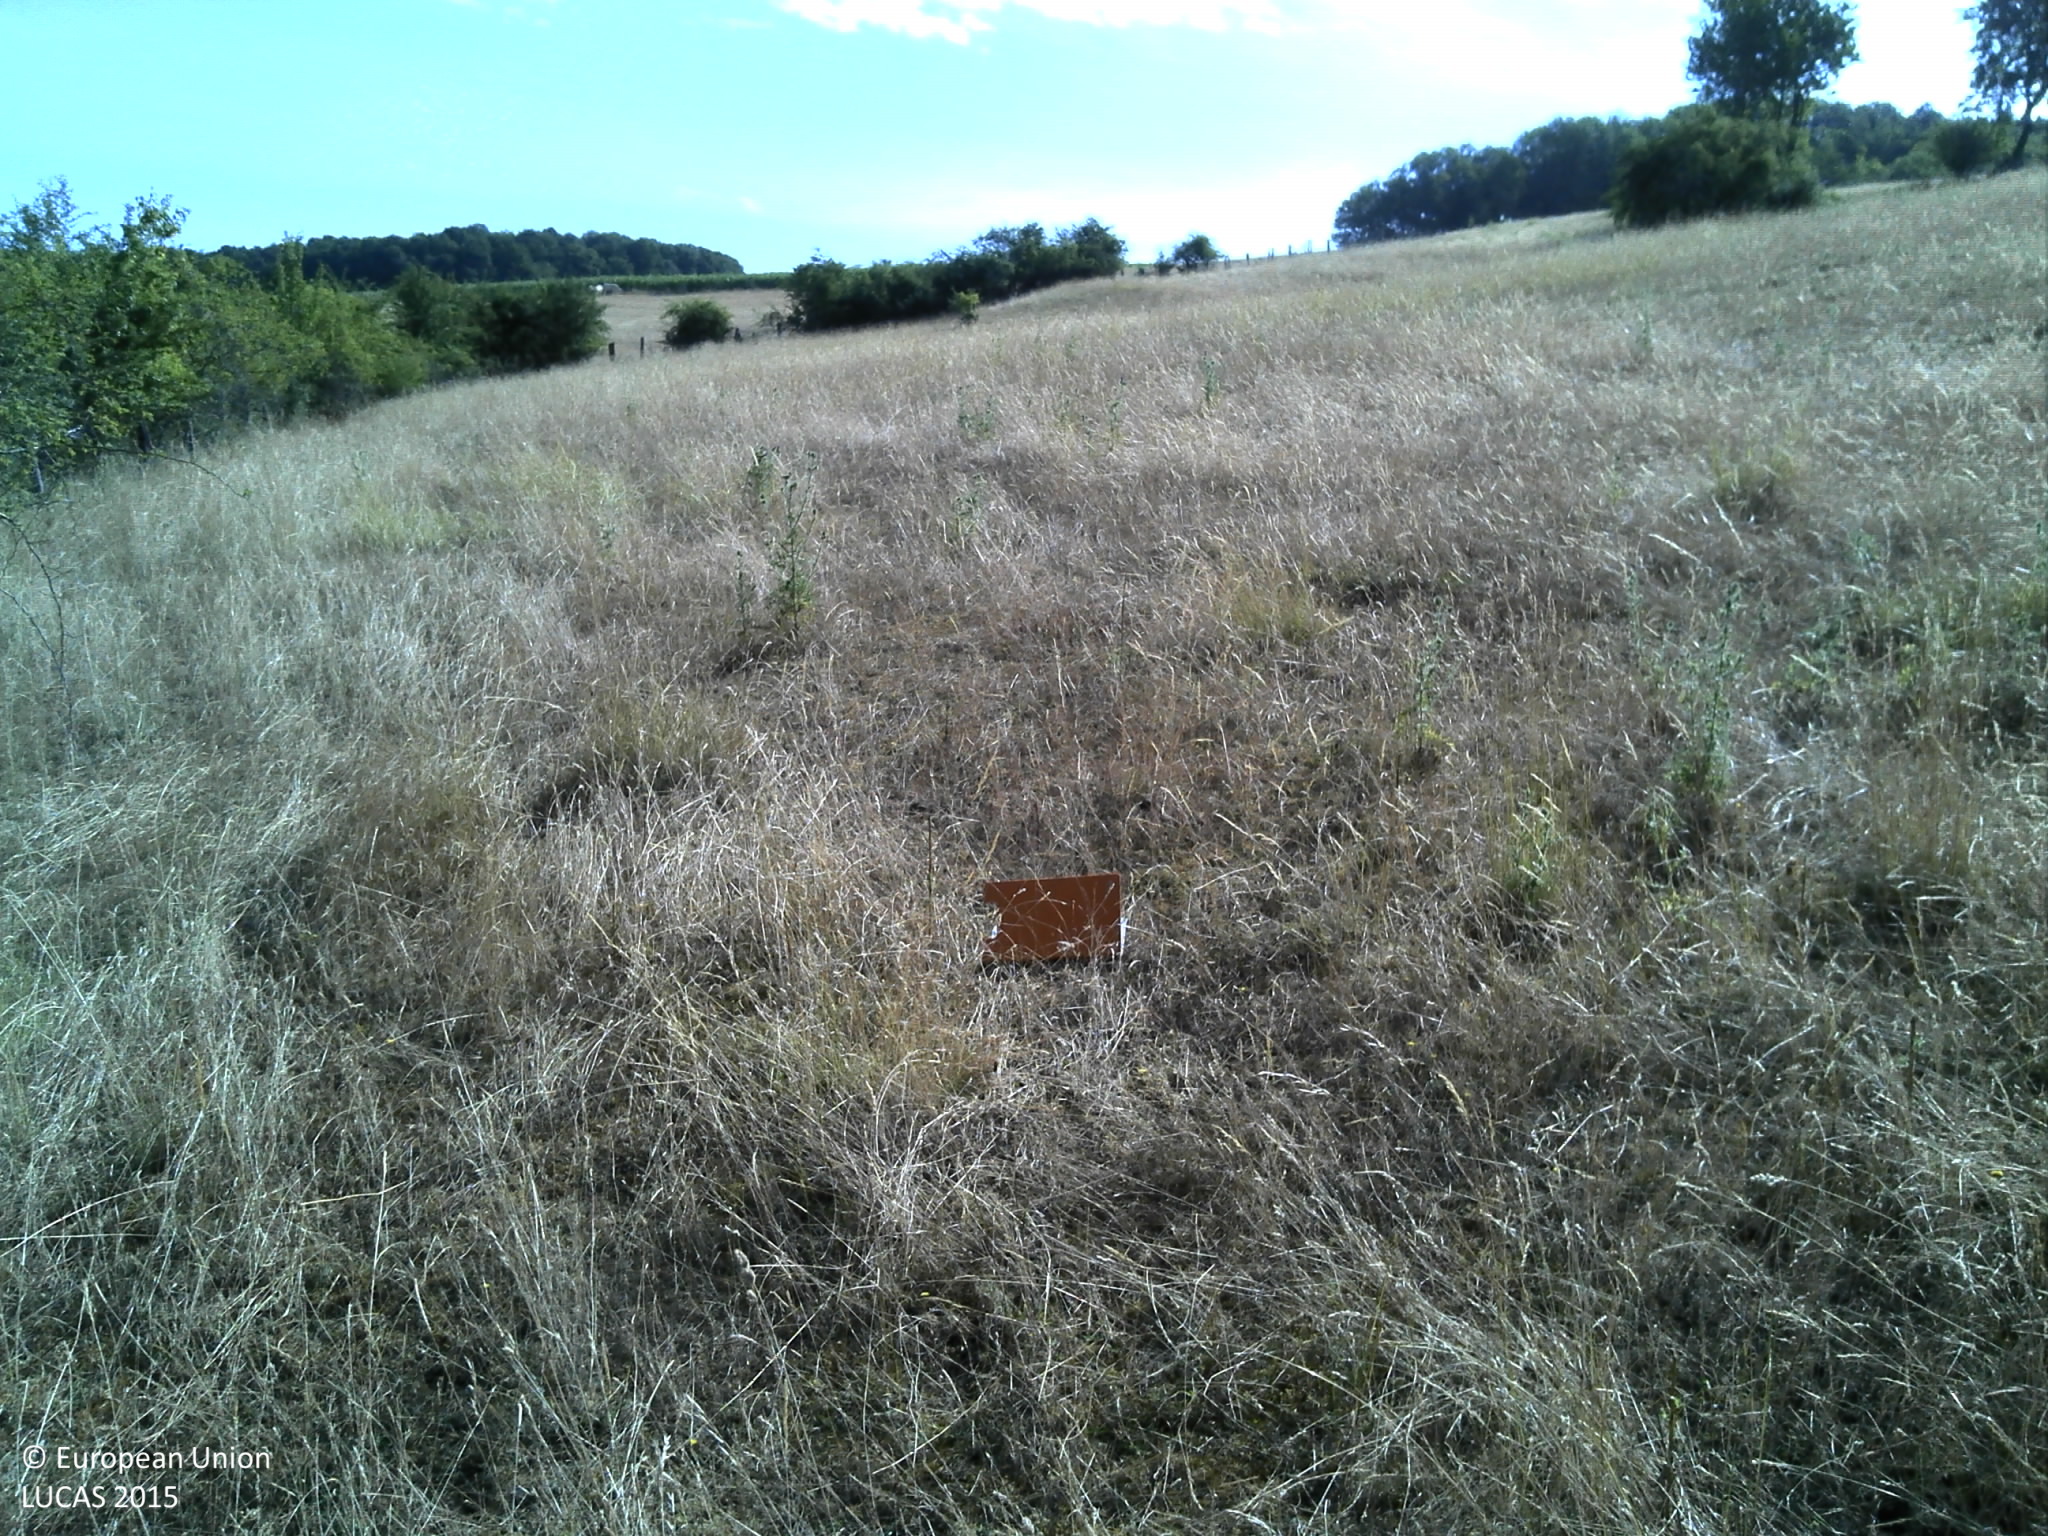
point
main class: Grassland
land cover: Grassland with sparse tree/shrub cover
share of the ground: > 75 %
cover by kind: herbaceous plants 95 %, broadleaved forest trees 5 %
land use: Agriculture (excluding fallow land and kitchen gardens)
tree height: < 5 m
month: July
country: FR
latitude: 48.3053
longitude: 6.2929
